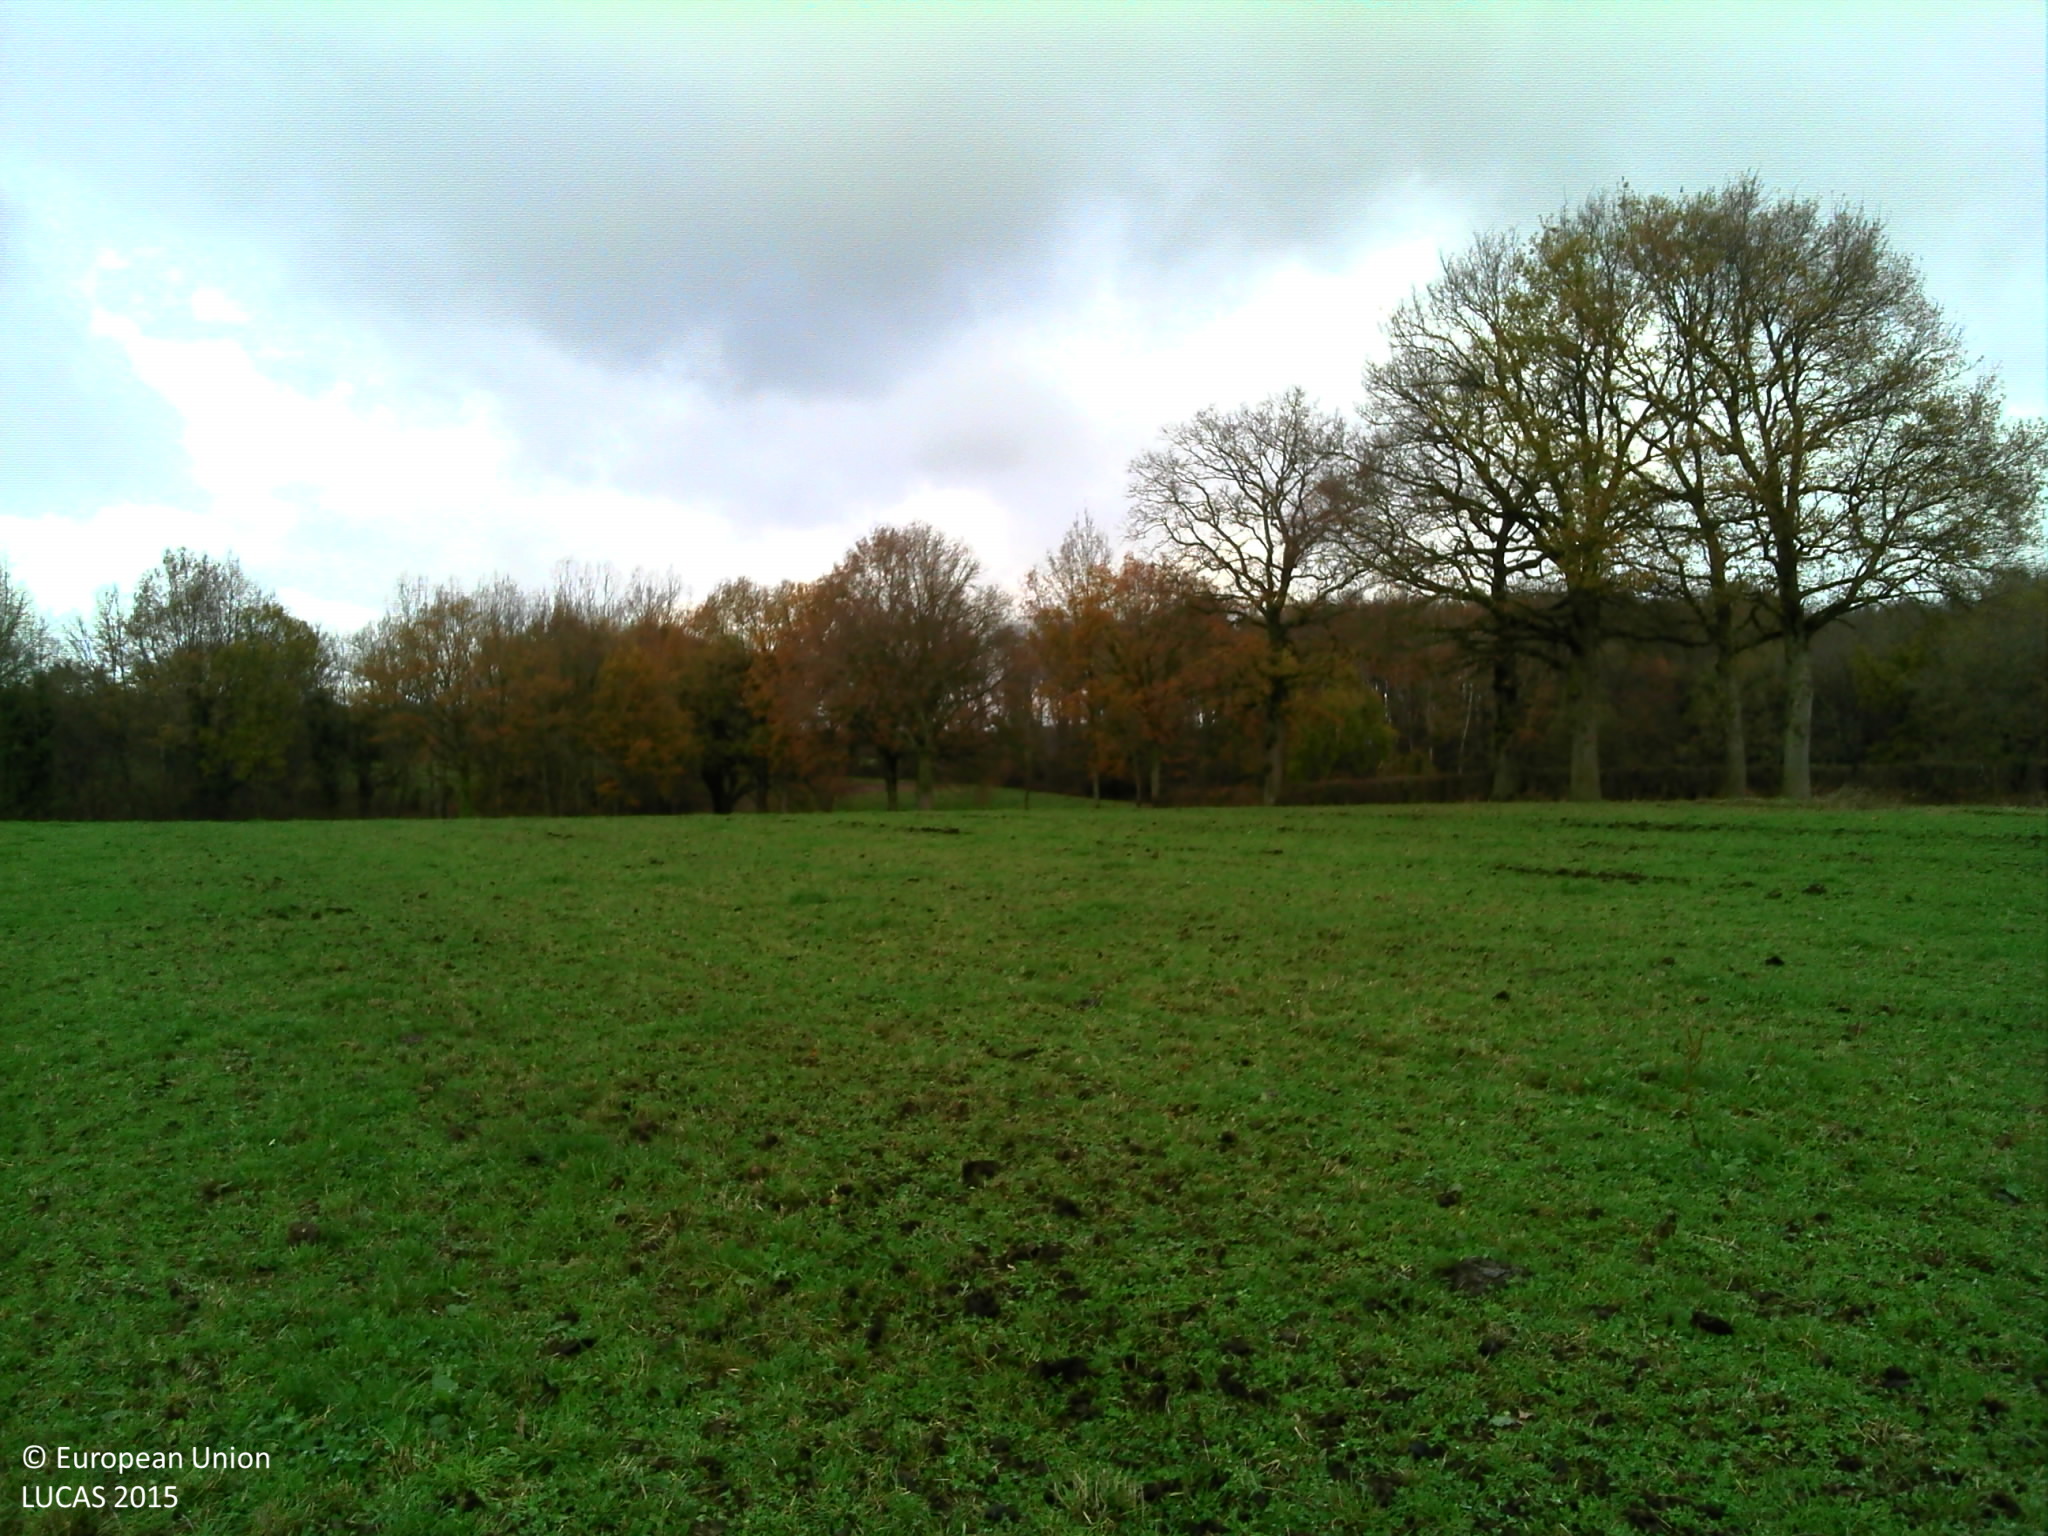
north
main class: Grassland
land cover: Grassland without tree/shrub cover
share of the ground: > 75 %
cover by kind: herbaceous plants 100 %
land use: Agriculture (excluding fallow land and kitchen gardens)
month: August
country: FR
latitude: 46.4310
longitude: 3.6096
